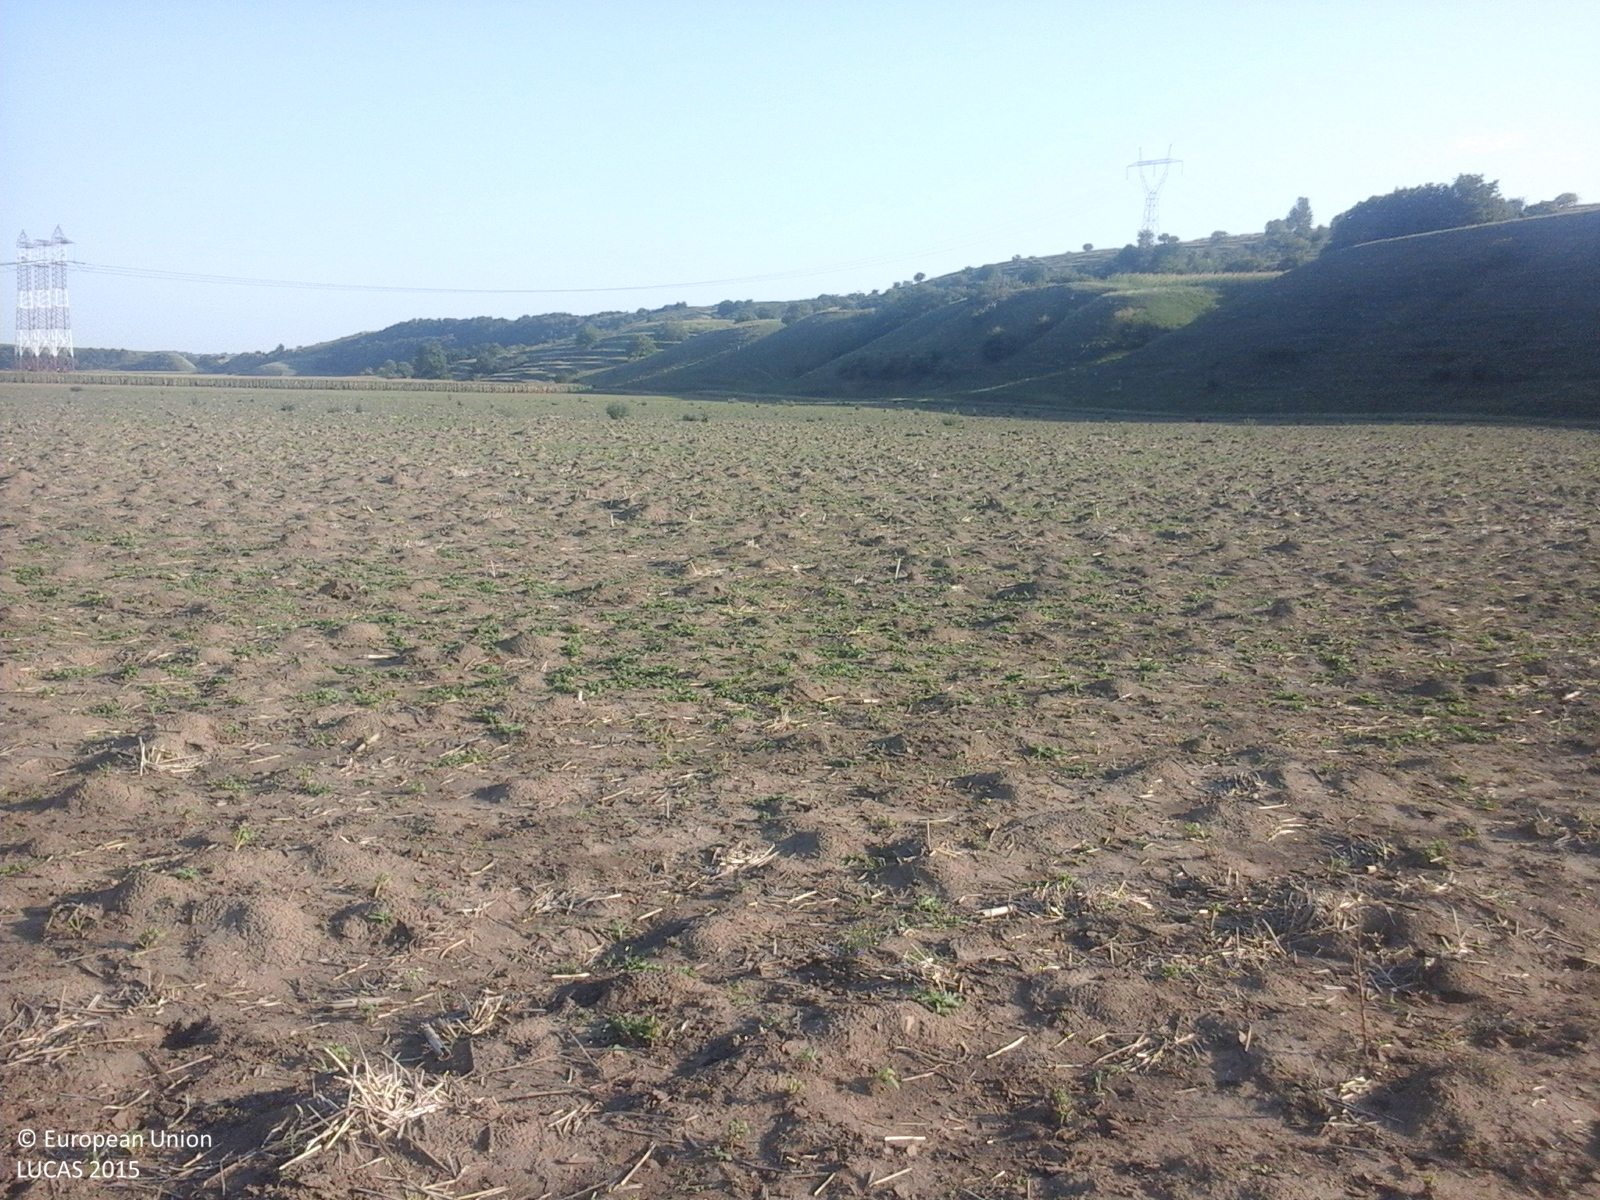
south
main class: Cropland
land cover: Common wheat
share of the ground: < 10 %
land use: Agriculture (excluding fallow land and kitchen gardens)
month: August
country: RO
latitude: 46.3173
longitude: 27.0169
